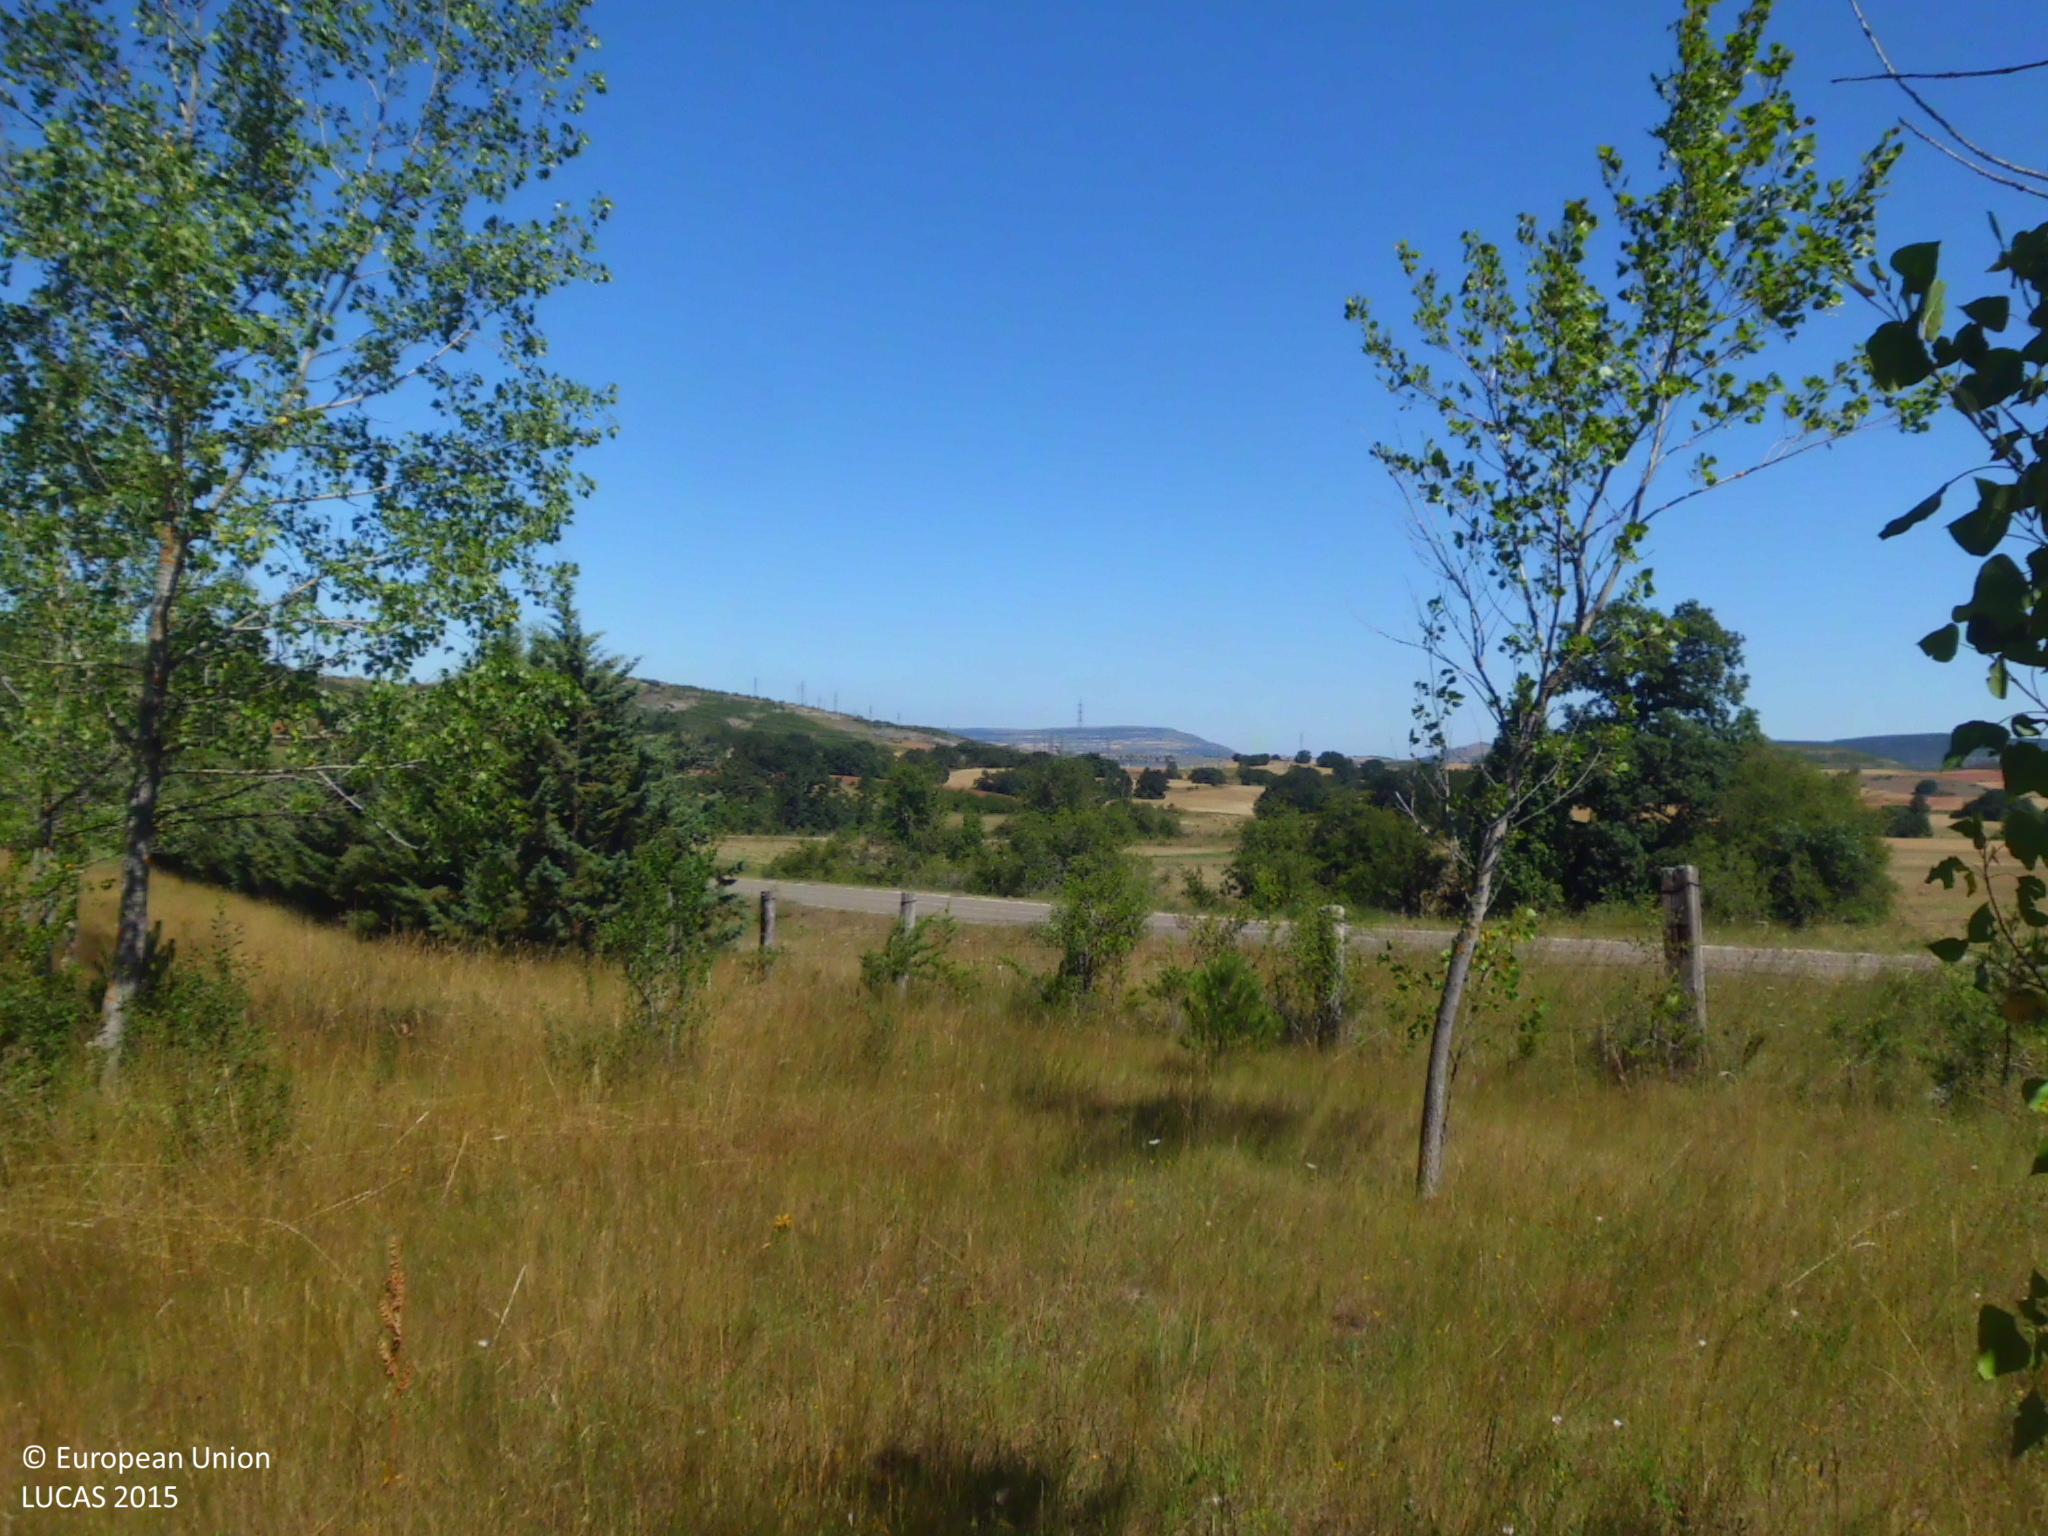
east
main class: Grassland
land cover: Grassland with sparse tree/shrub cover
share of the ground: > 75 %
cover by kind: herbaceous plants 95 %, broadleaved forest trees 5 %
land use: Semi-natural and natural areas not in use
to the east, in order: Grassland with sparse tree/shrub cover; Conifer hedges; Fences; Grassland without tree/shrub cover; Paved roads, cycling and walking lanes; Grassland with sparse tree/shrub cover; Grassland without tree/shrub cover; Tracks; Broadleaved woodland; Grassland without tree/shrub cover
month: July
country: ES
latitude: 42.7879
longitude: -4.2924
